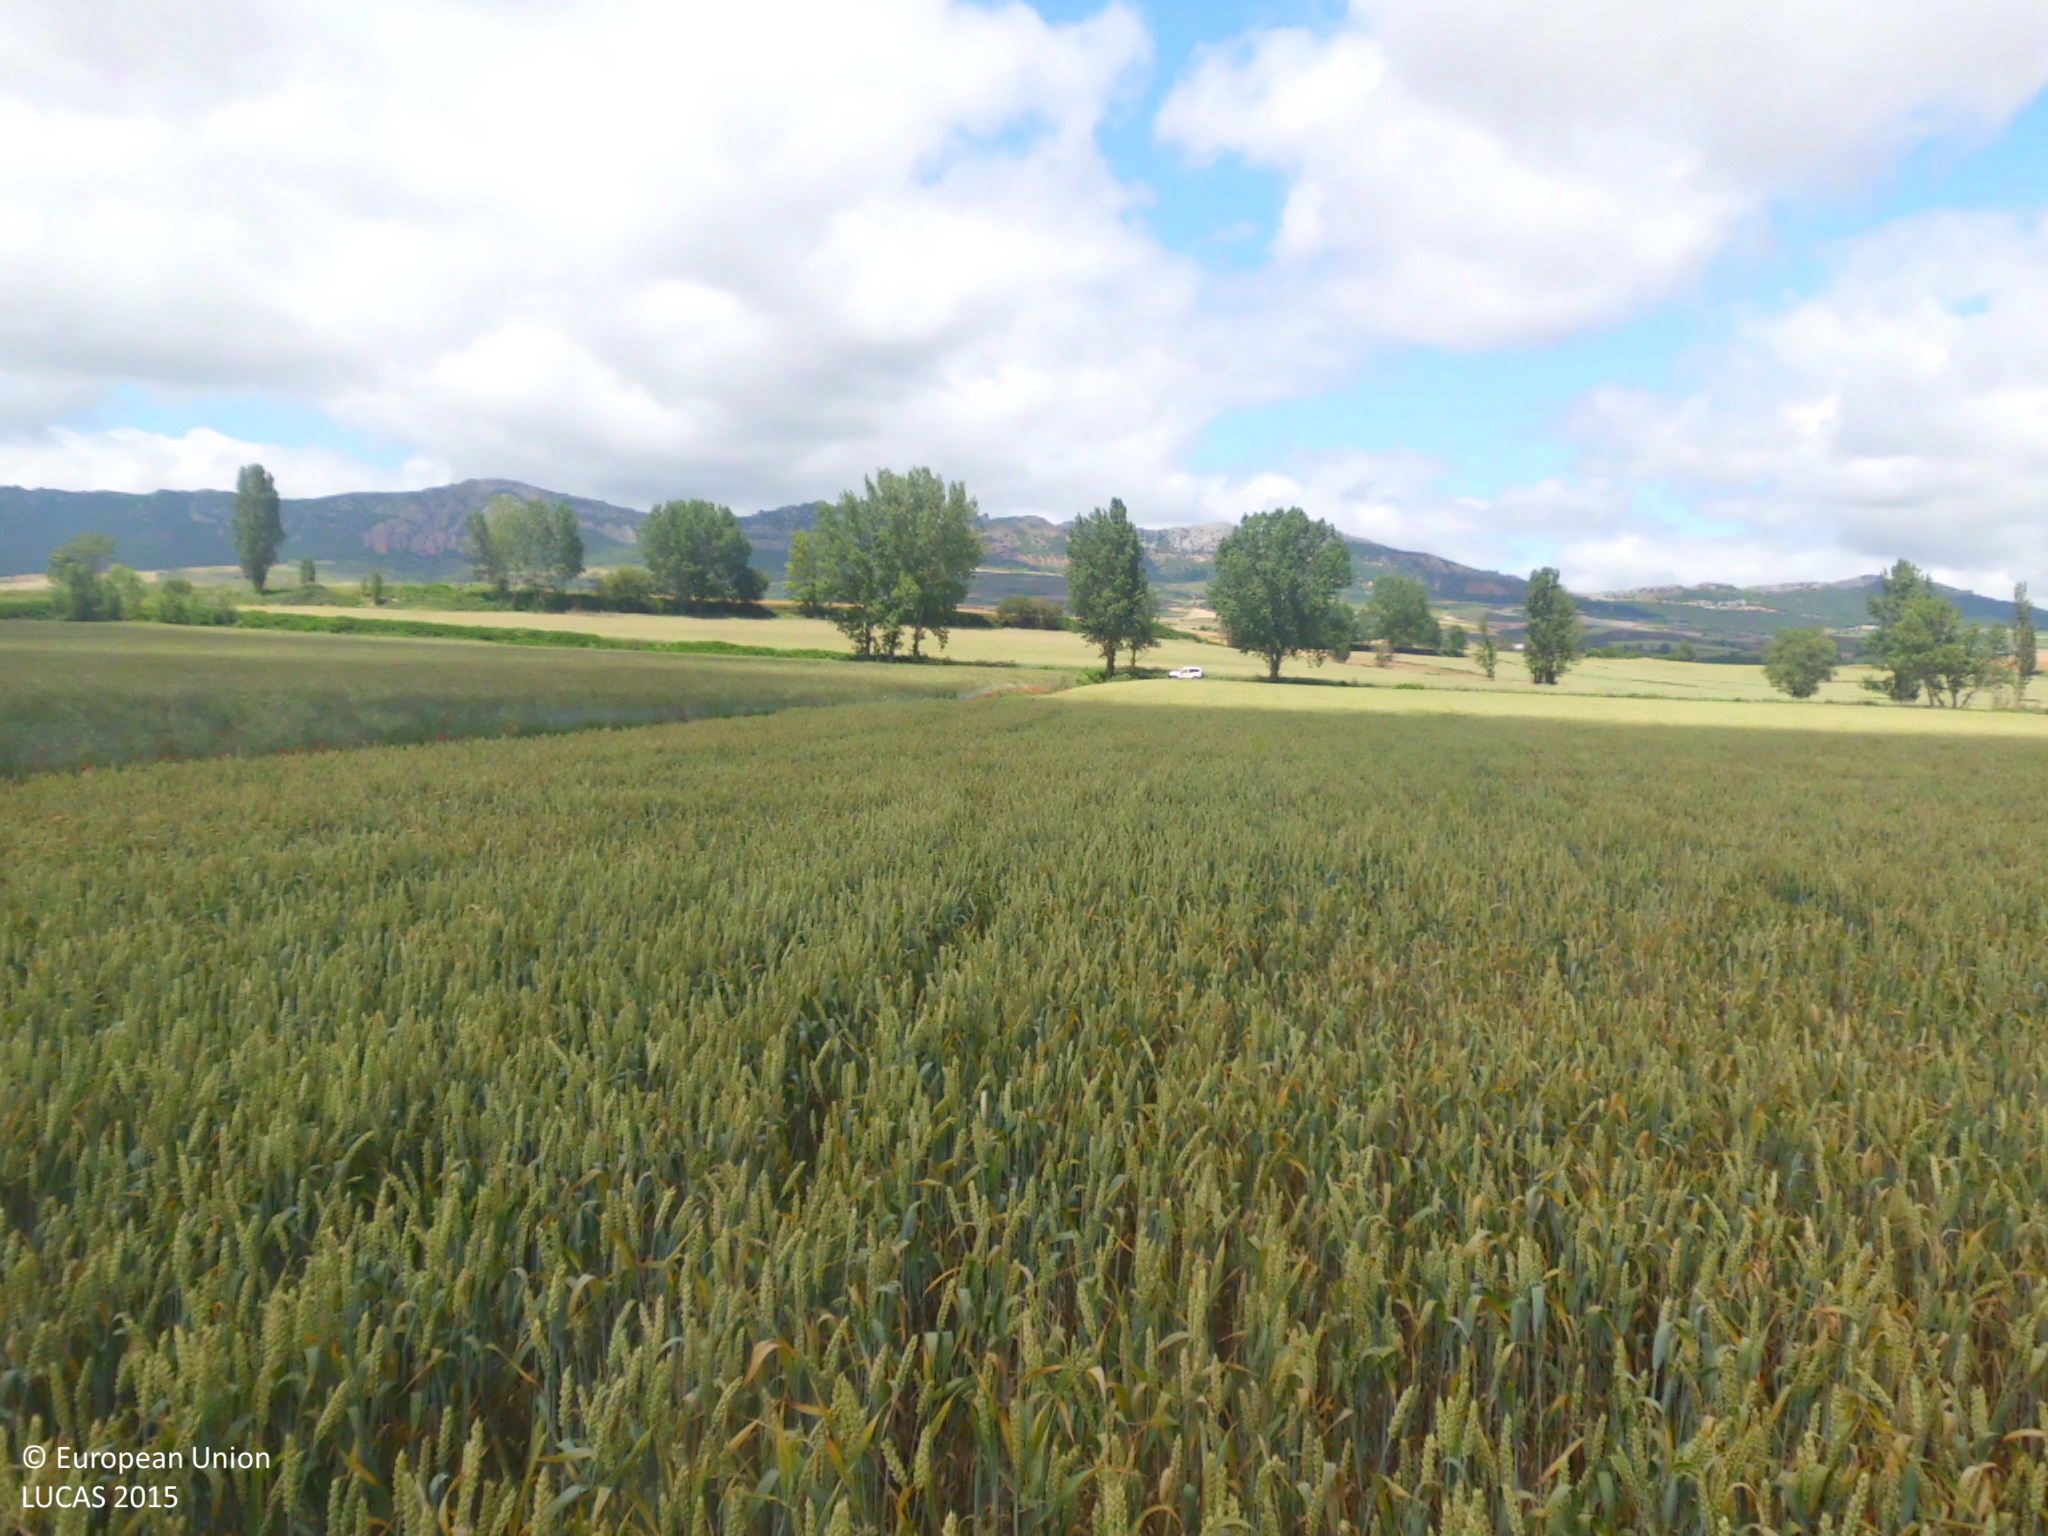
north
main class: Cropland
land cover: Common wheat
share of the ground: > 75 %
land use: Agriculture (excluding fallow land and kitchen gardens)
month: June
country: ES
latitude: 42.6508
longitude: -3.2925
